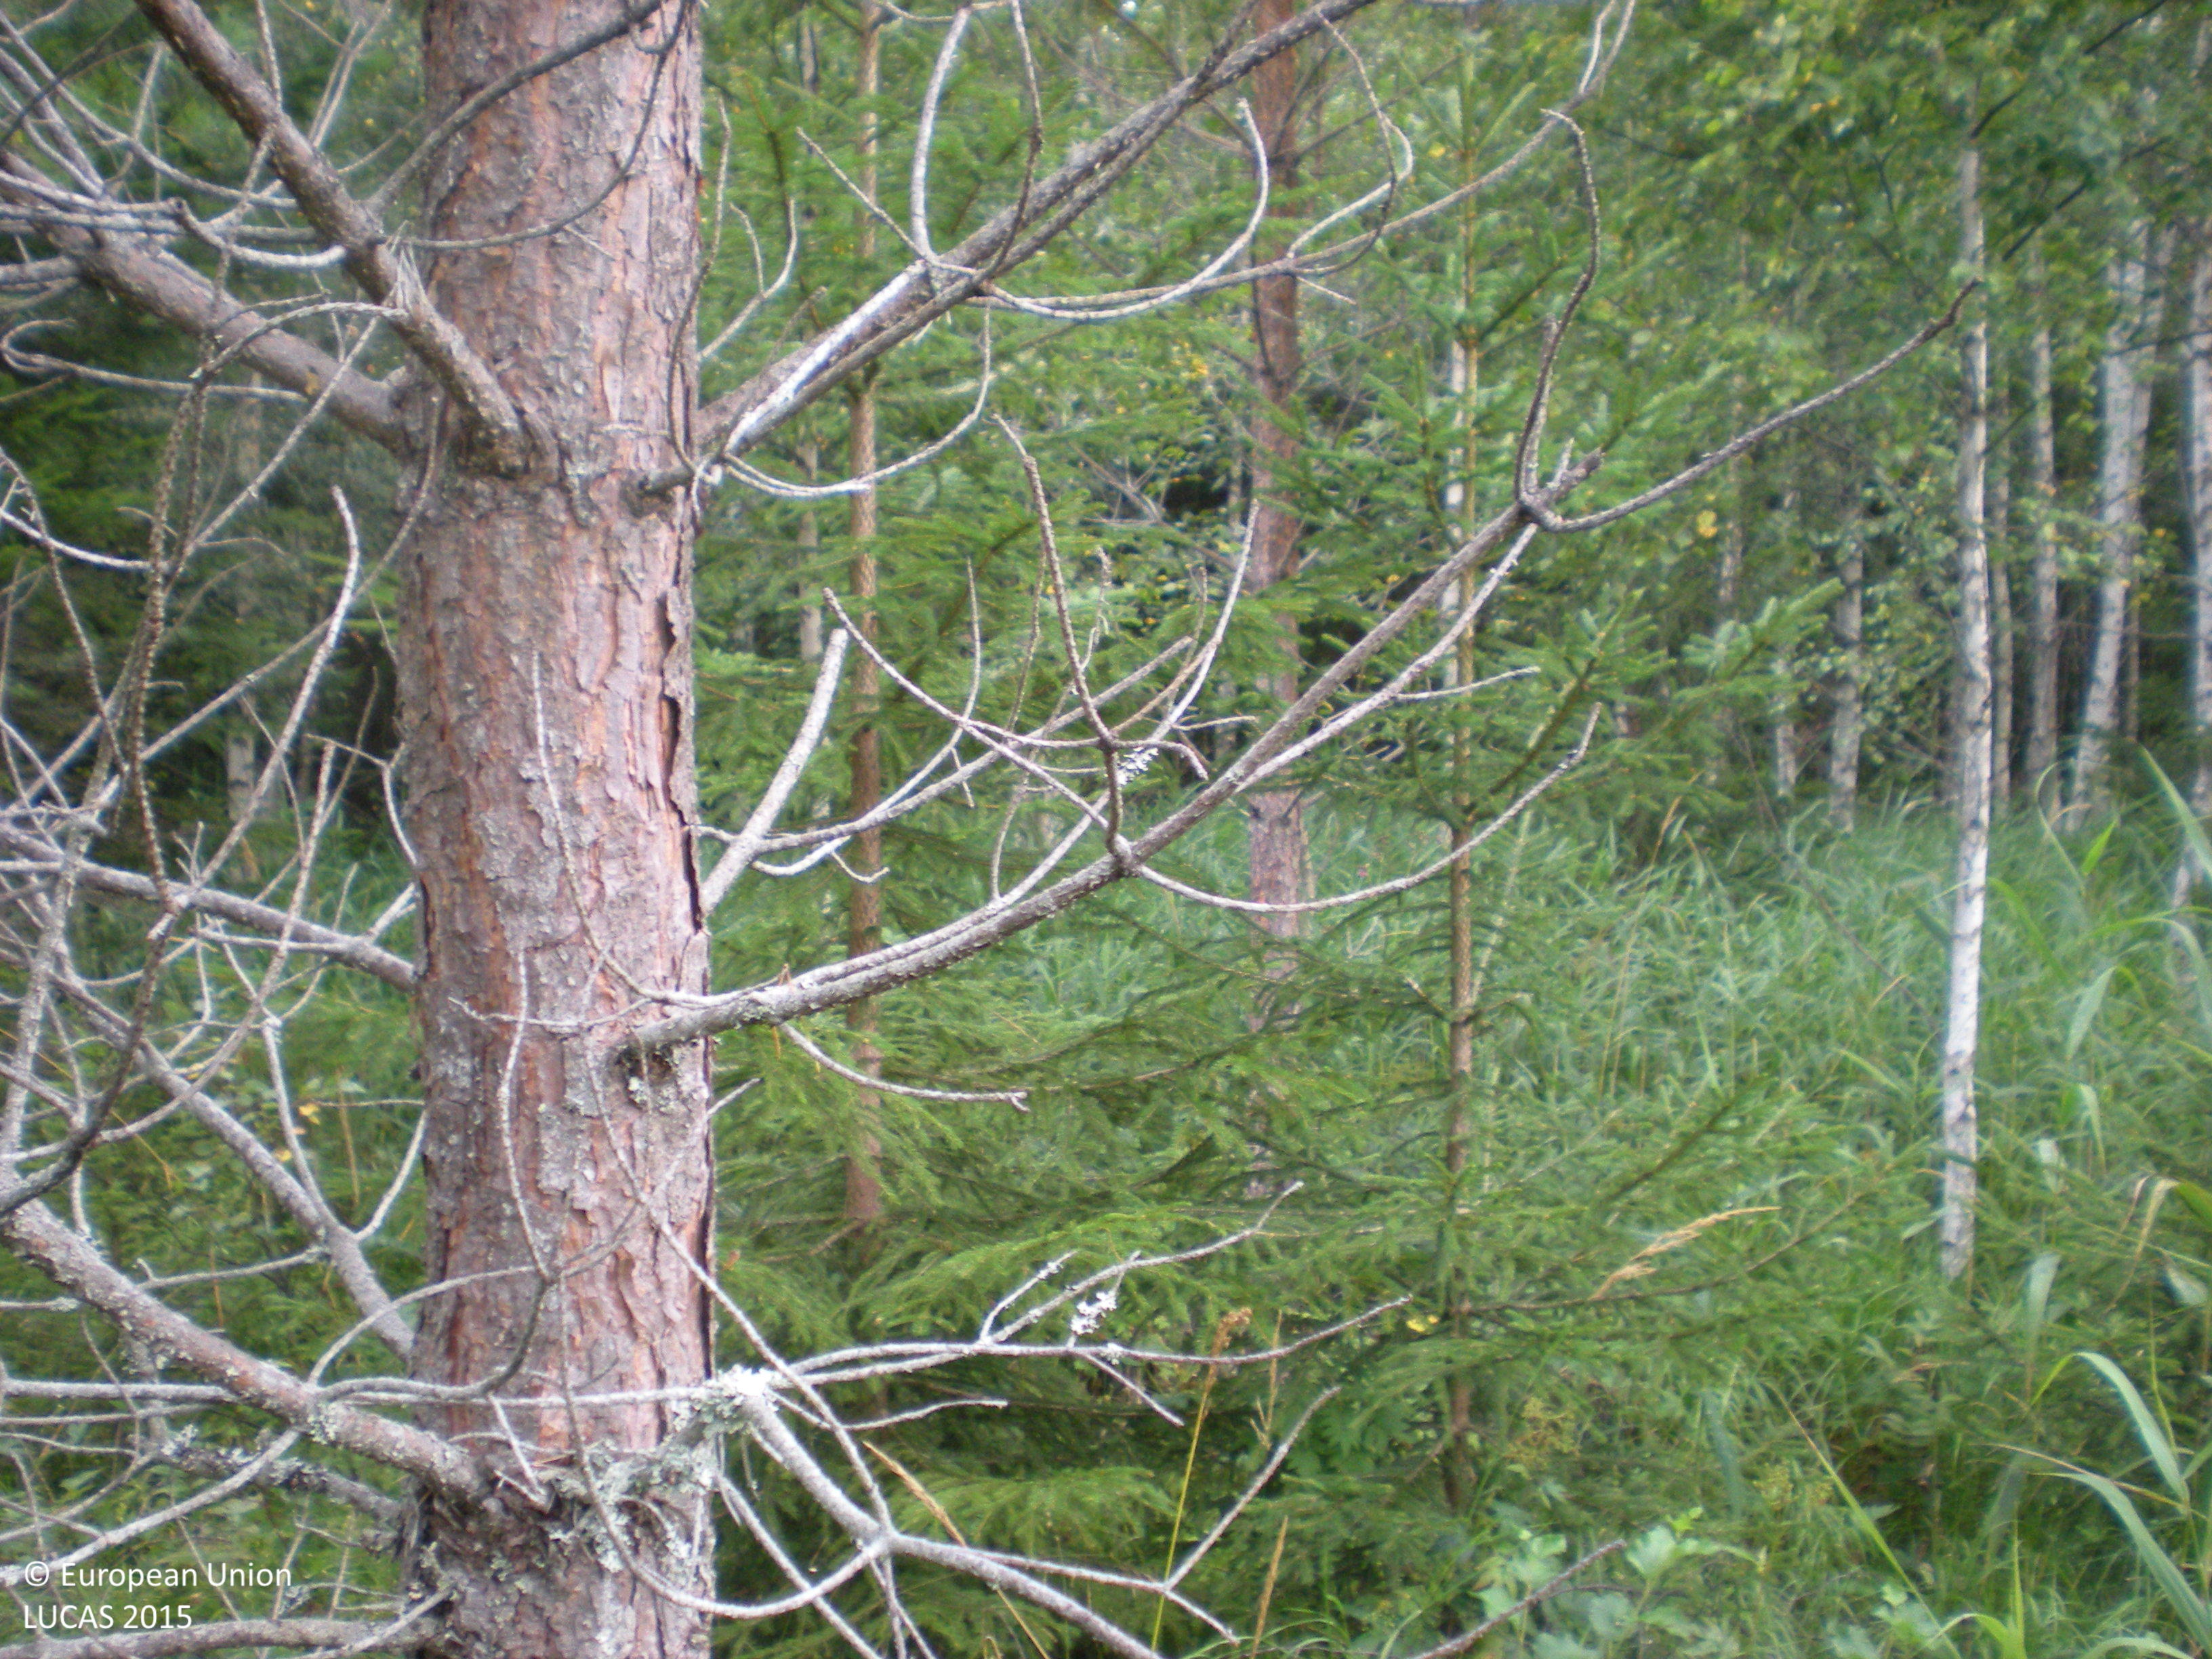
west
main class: Woodland
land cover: Spruce dominated mixed woodland
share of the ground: 50 - 75 %
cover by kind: coniferous forest trees 55 %, herbaceous plants 25 %, broadleaved forest trees 20 %
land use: Forestry
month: August
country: SE
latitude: 60.5256
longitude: 17.1136
